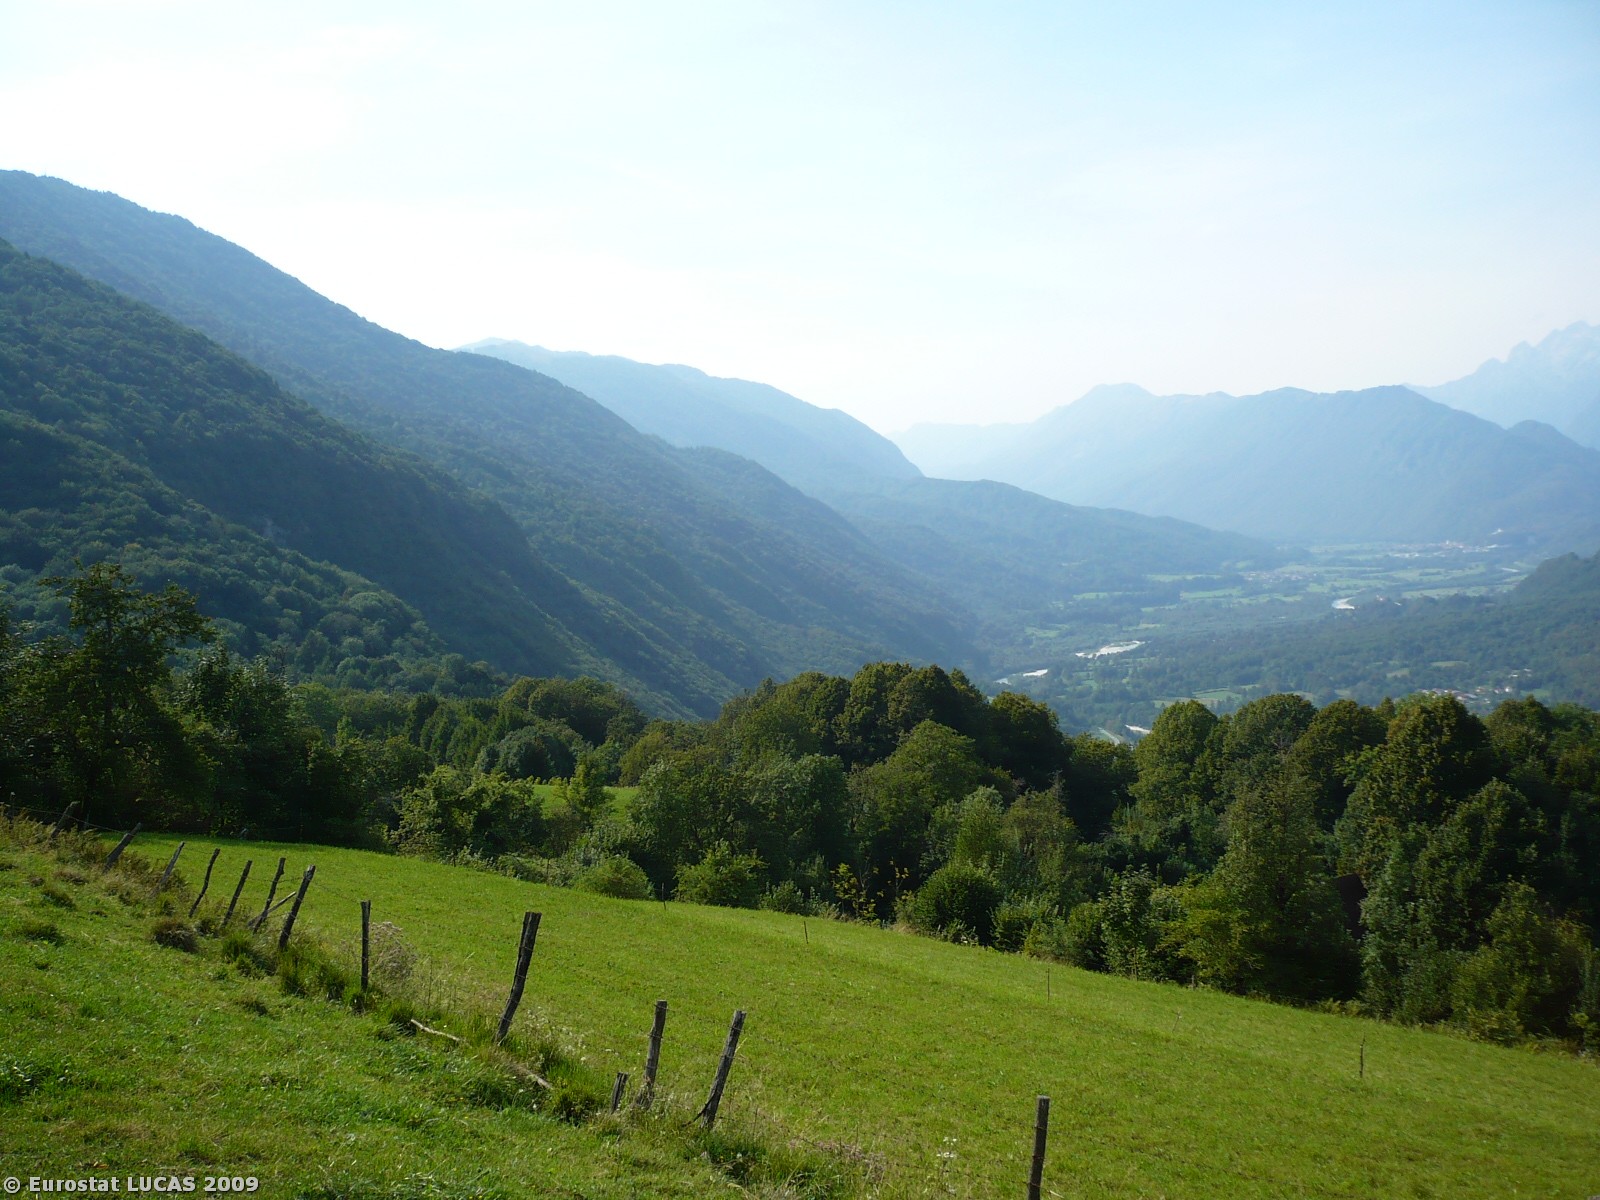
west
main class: Grassland
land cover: Grassland without tree/shrub cover
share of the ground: > 75 %
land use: Agriculture (excluding fallow land and kitchen gardens)
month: August
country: SI
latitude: 46.1983
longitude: 13.6639
